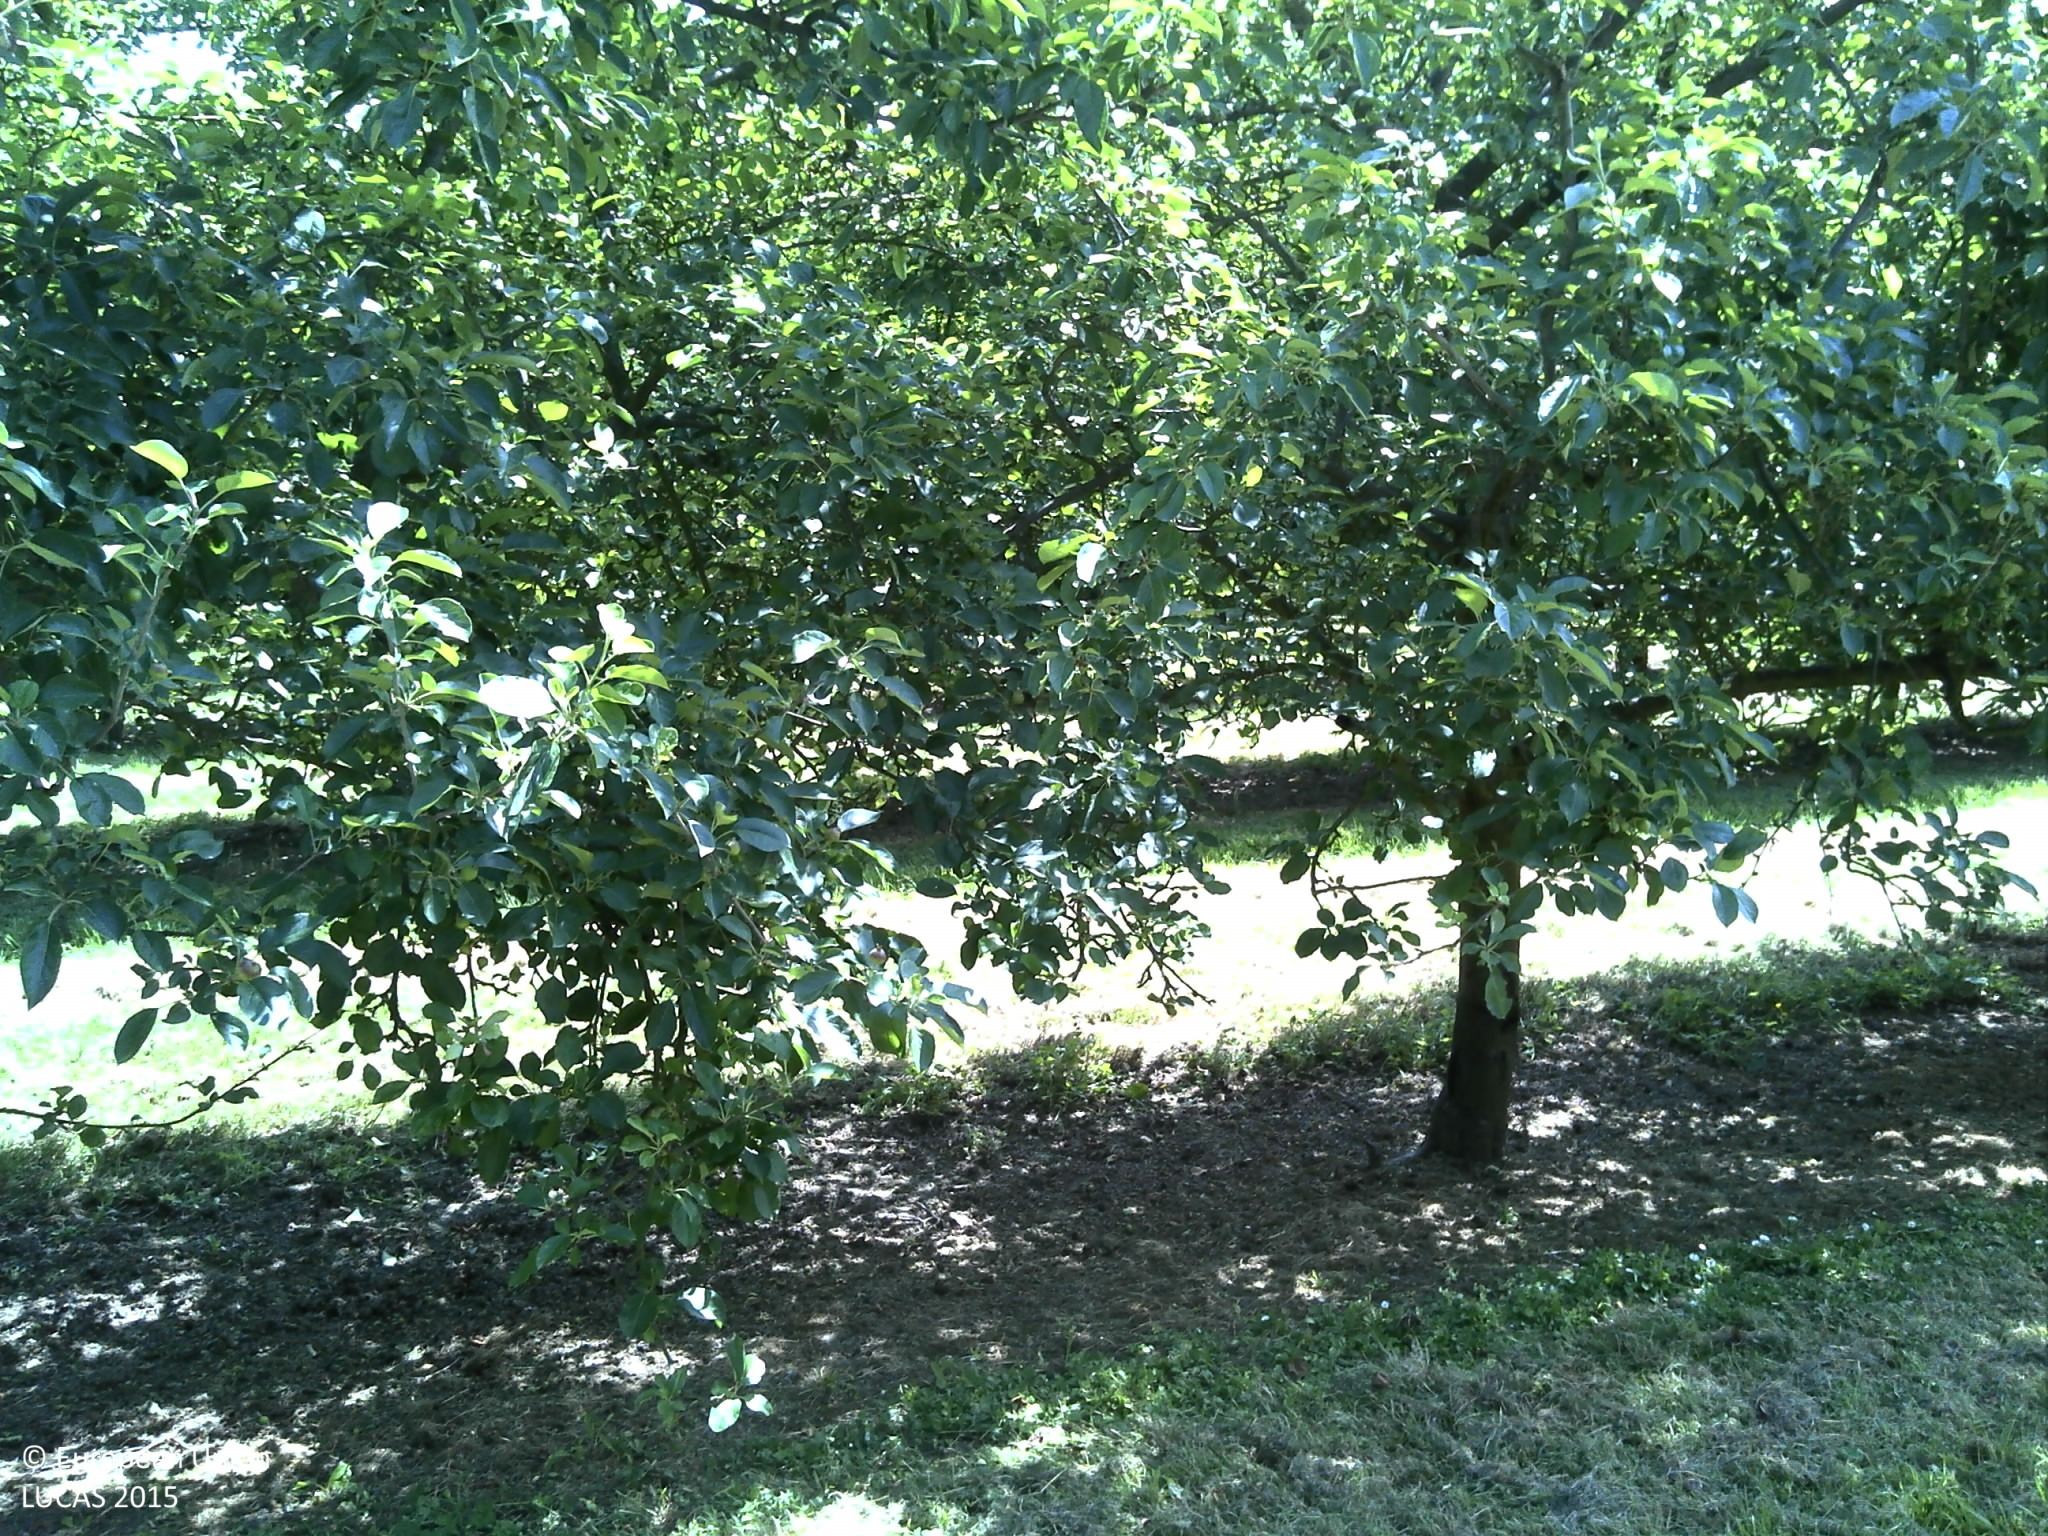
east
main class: Cropland
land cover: Apple fruit
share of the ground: 50 - 75 %
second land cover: Grassland without tree/shrub cover
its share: 50 - 75 %
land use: Agriculture (excluding fallow land and kitchen gardens)
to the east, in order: Apple fruit; Grassland without tree/shrub cover
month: June
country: FR
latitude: 49.7816
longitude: 1.1037
